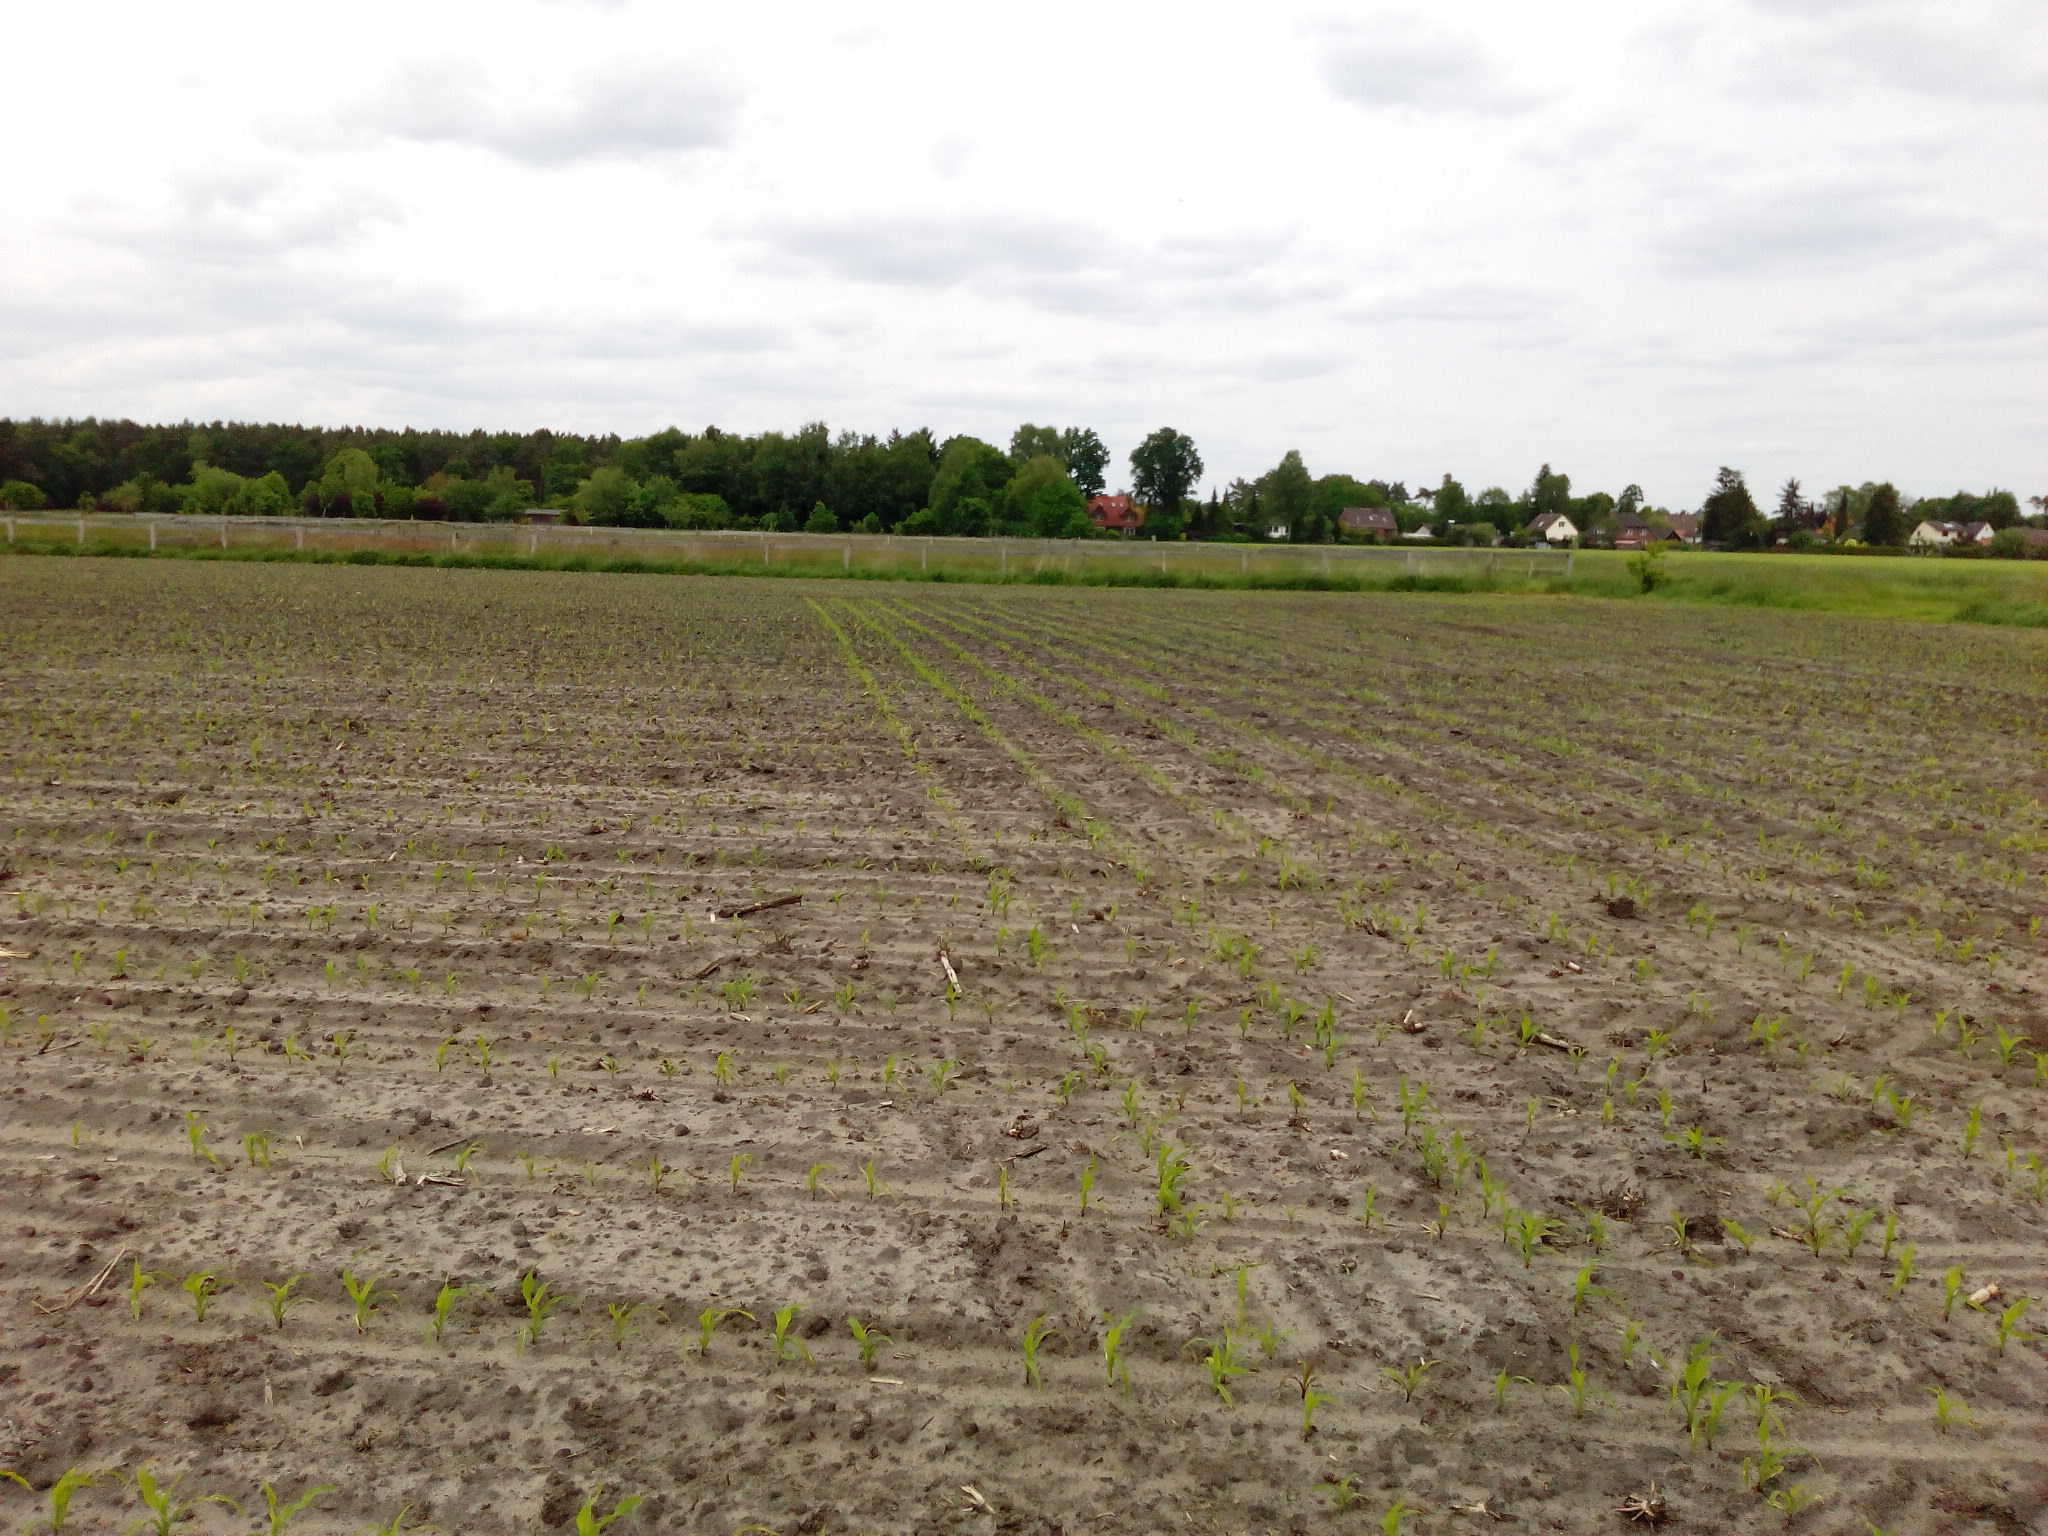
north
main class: Cropland
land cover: Maize
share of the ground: < 10 %
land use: Agriculture (excluding fallow land and kitchen gardens)
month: June
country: DE
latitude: 52.6470
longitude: 9.9261
